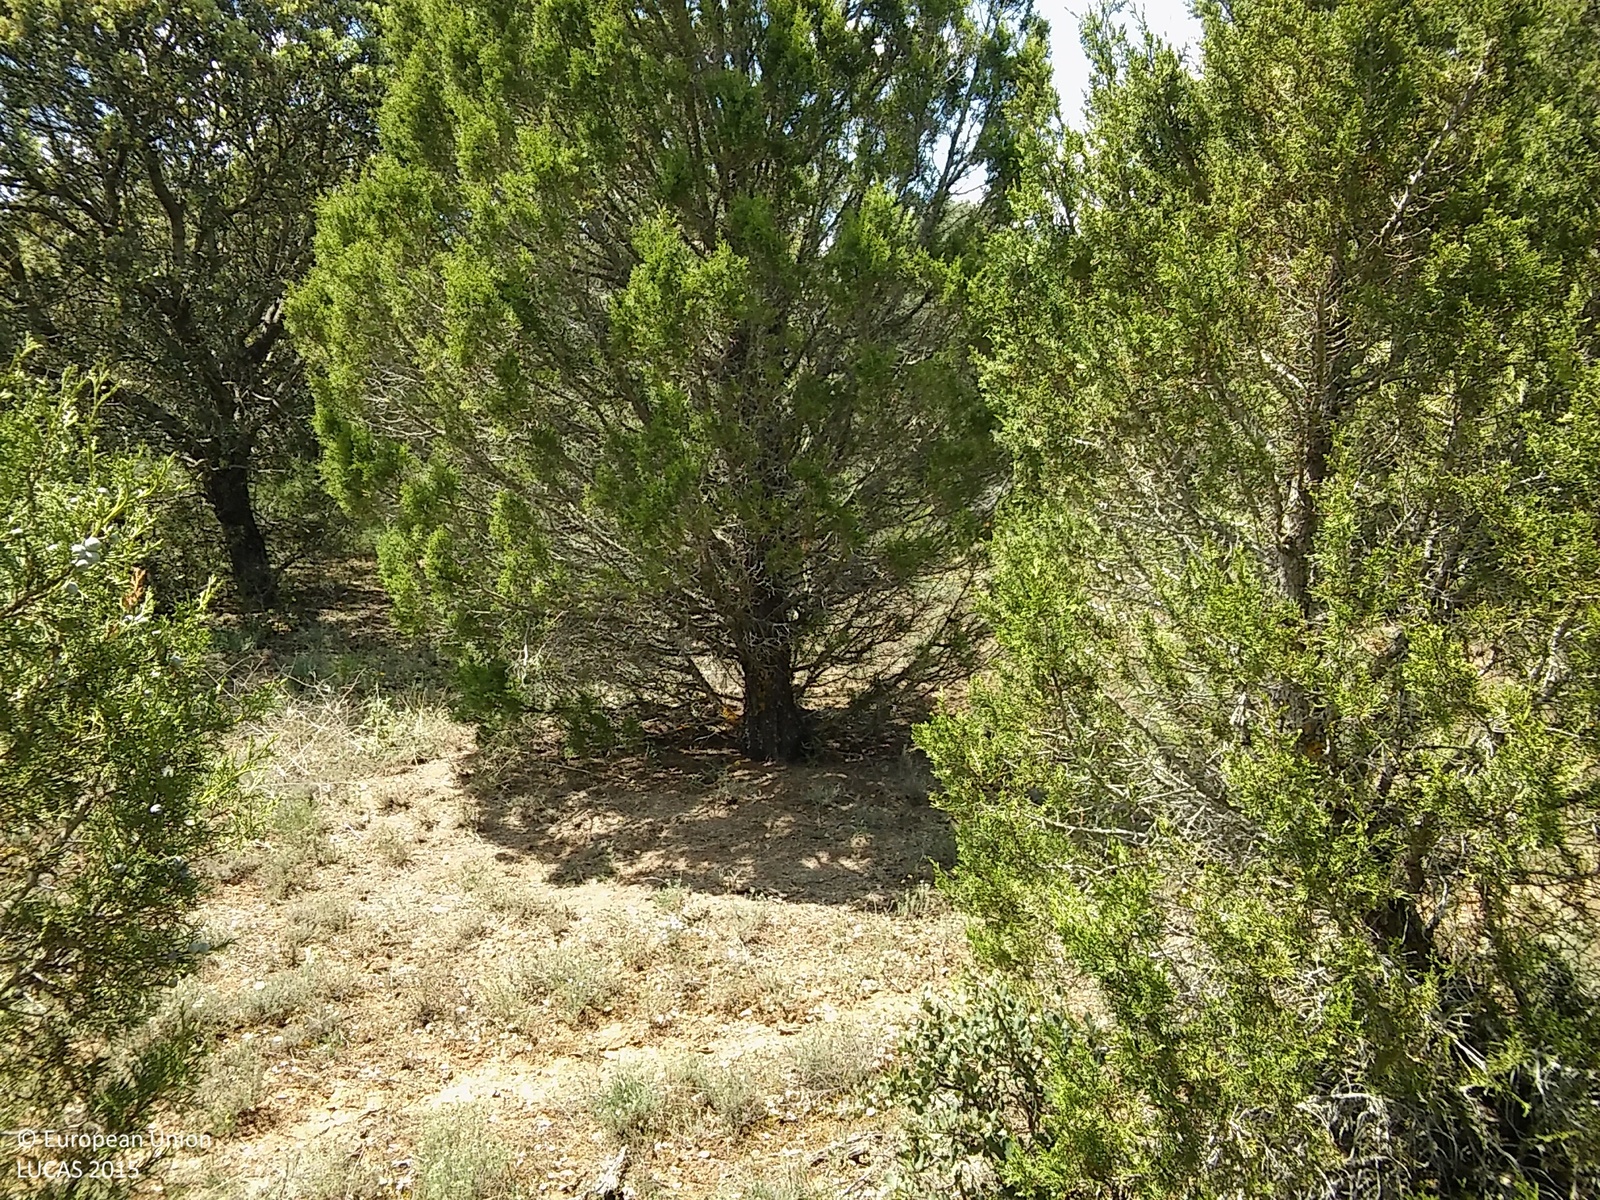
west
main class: Woodland
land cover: Other mixed woodland
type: coniferous forest of the mediterranean region
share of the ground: 25 - 50 %
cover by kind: coniferous forest trees 25 %, broadleaved forest trees 25 %, shrubs 25 %, unconsolidated bare surface 15 %, herbaceous plants 10 %
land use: Forestry
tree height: > 5 m
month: May
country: ES
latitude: 41.6075
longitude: -3.5736
